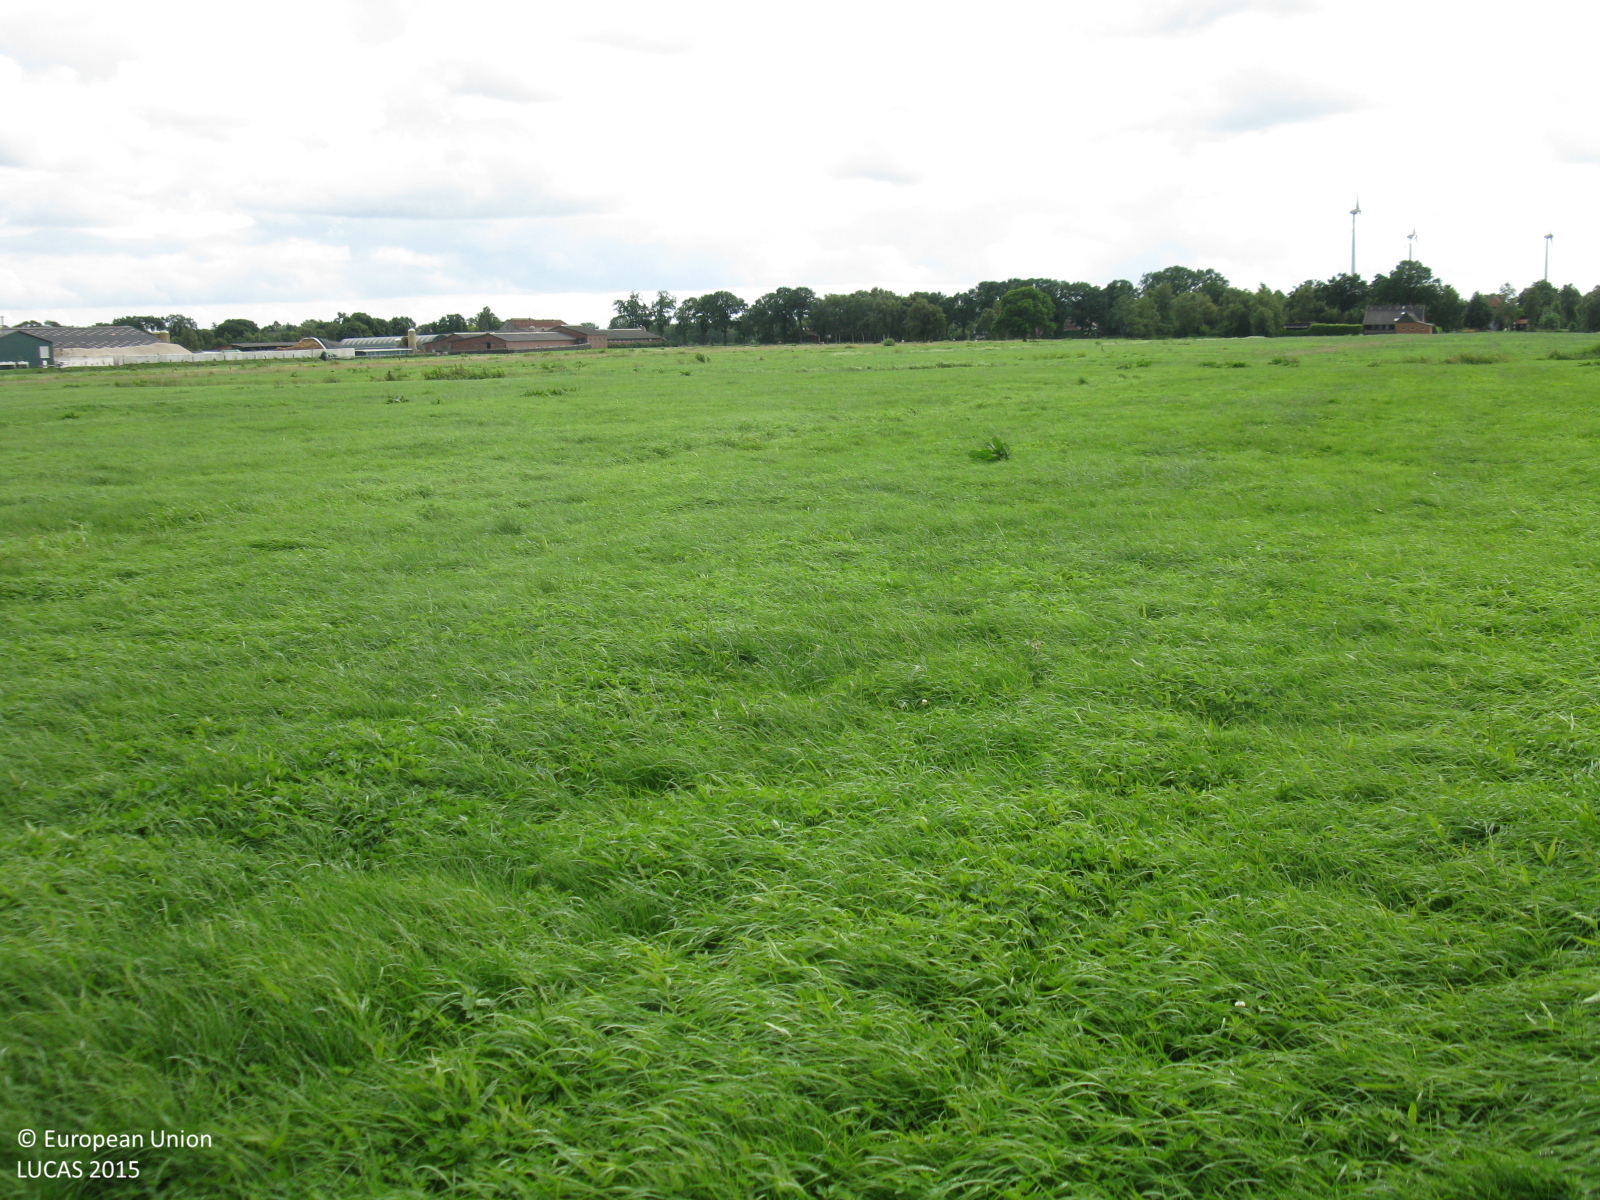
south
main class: Grassland
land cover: Grassland without tree/shrub cover
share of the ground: > 75 %
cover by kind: herbaceous plants 100 %
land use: Agriculture (excluding fallow land and kitchen gardens)
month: July
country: DE
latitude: 53.1581
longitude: 8.4303
